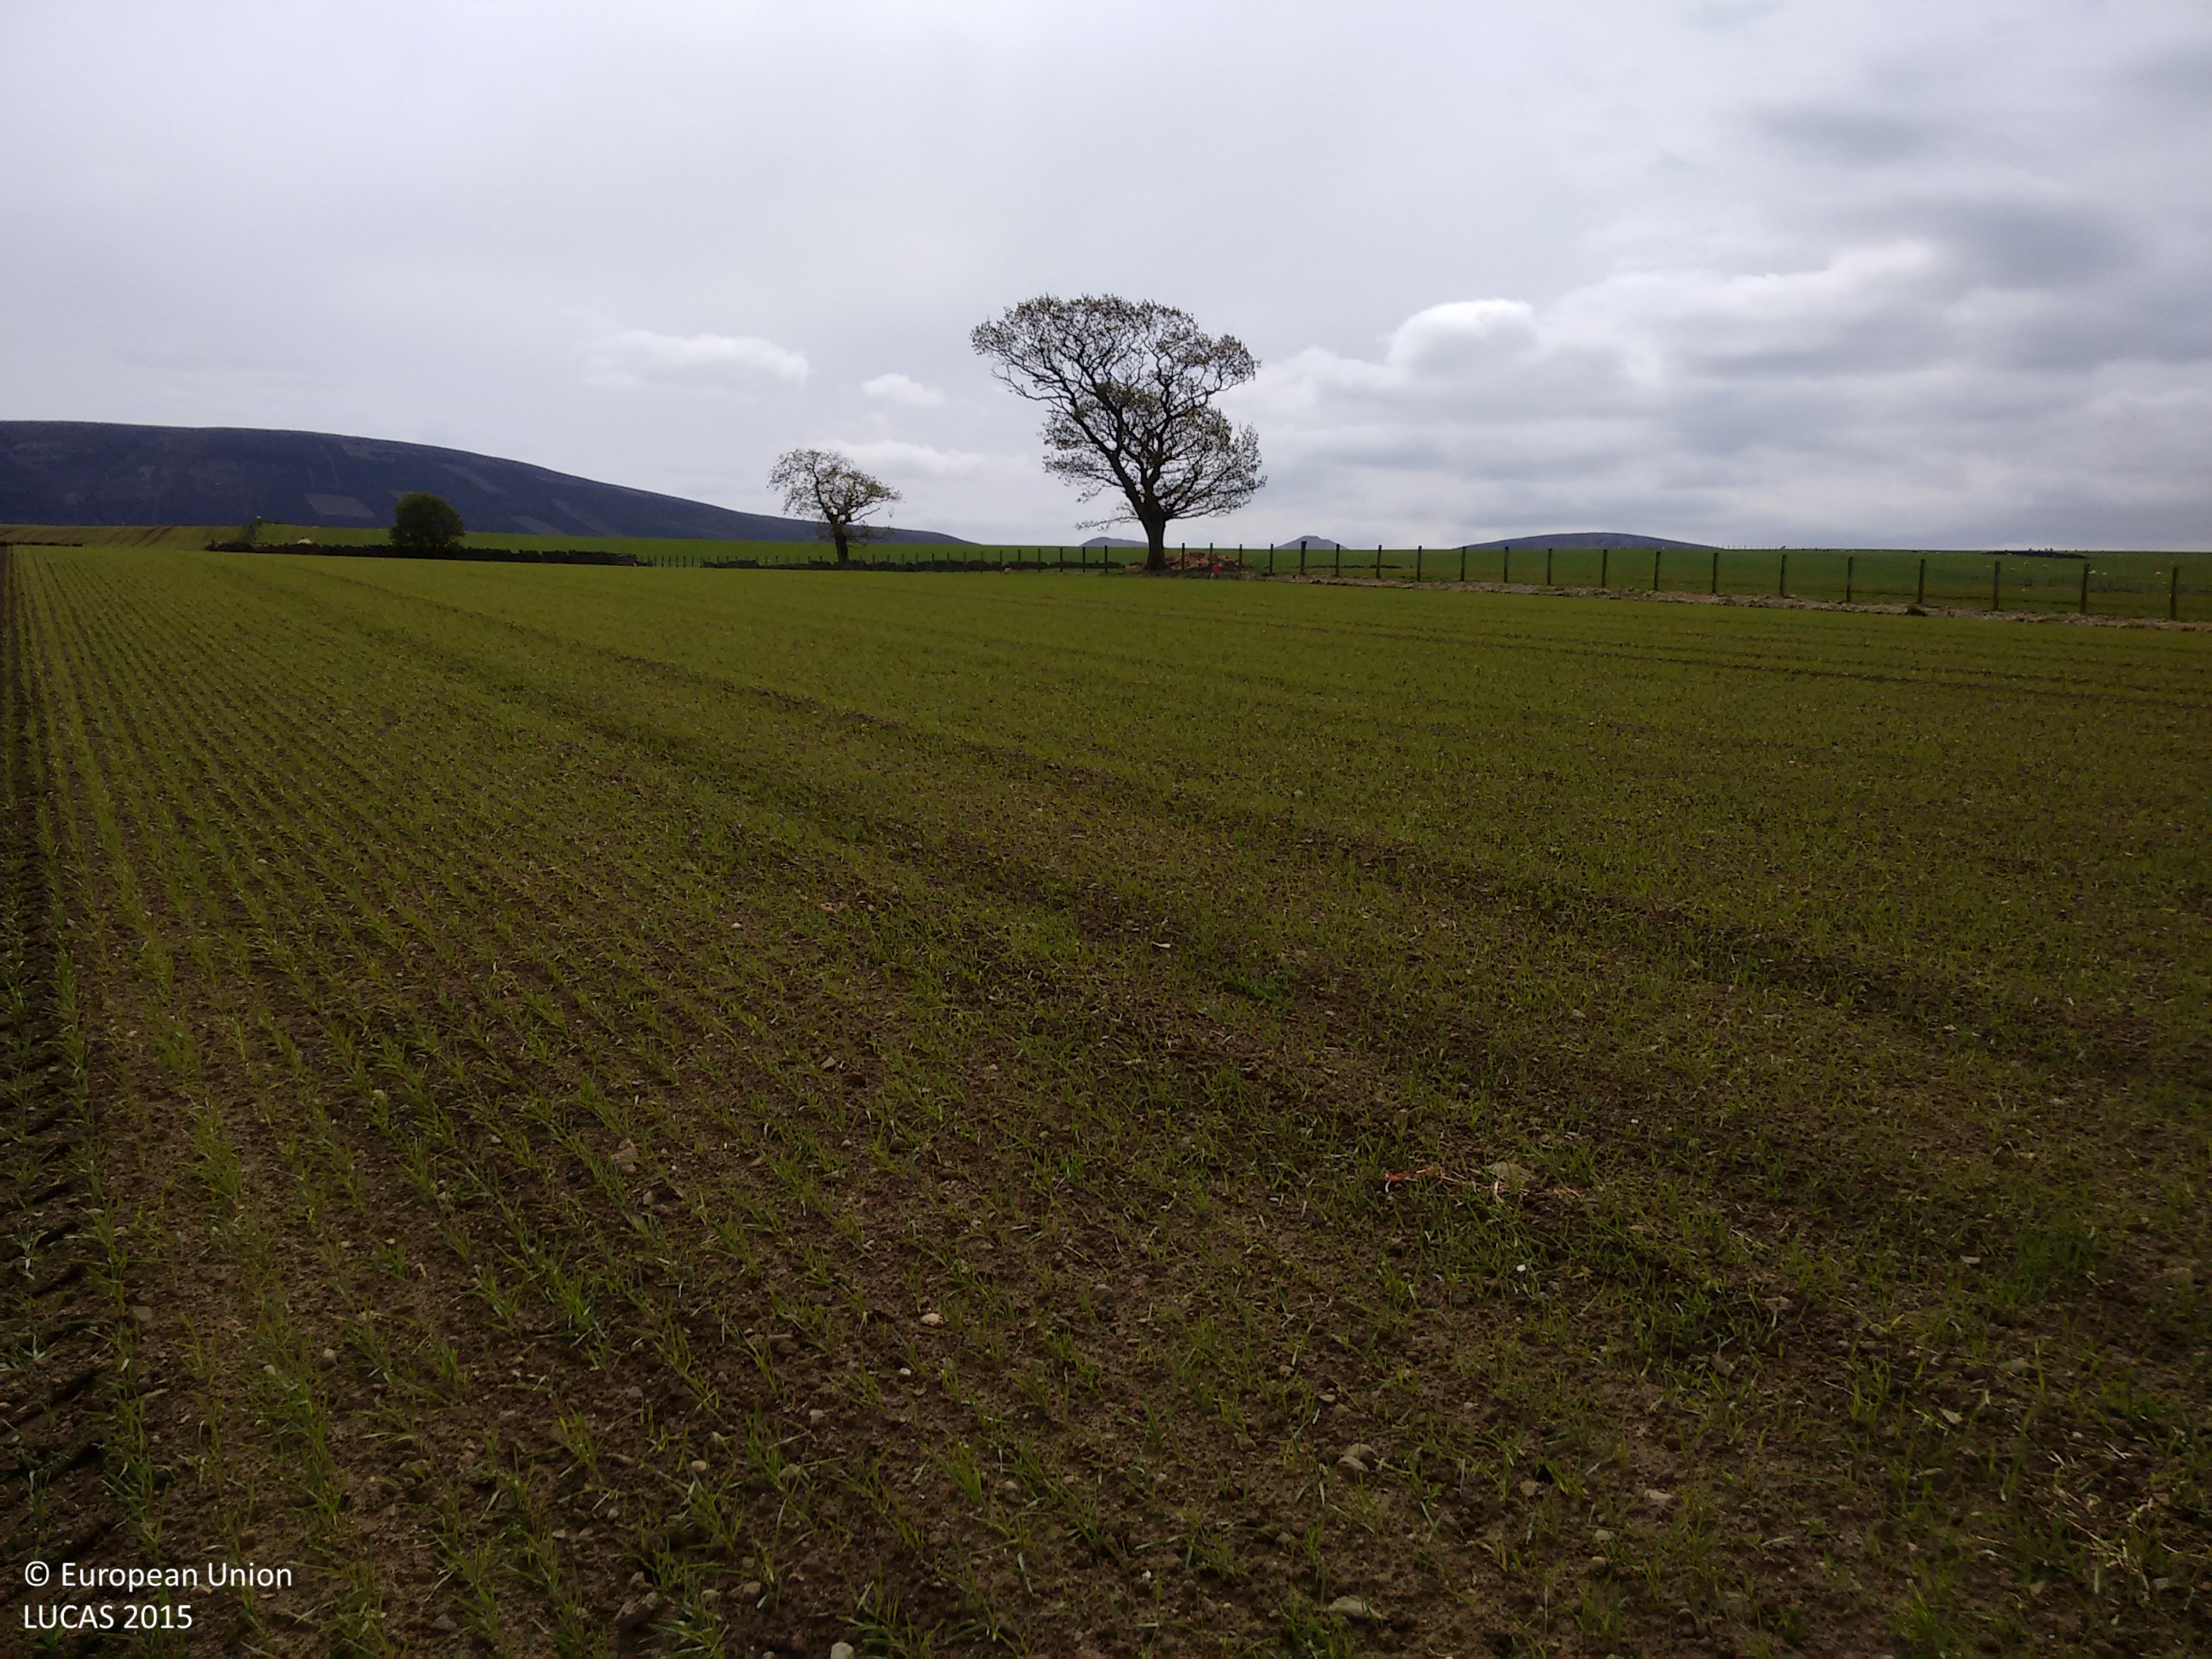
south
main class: Cropland
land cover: Barley
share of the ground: 10 - 25 %
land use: Agriculture (excluding fallow land and kitchen gardens)
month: May
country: GB
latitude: 55.8721
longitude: -3.3233
